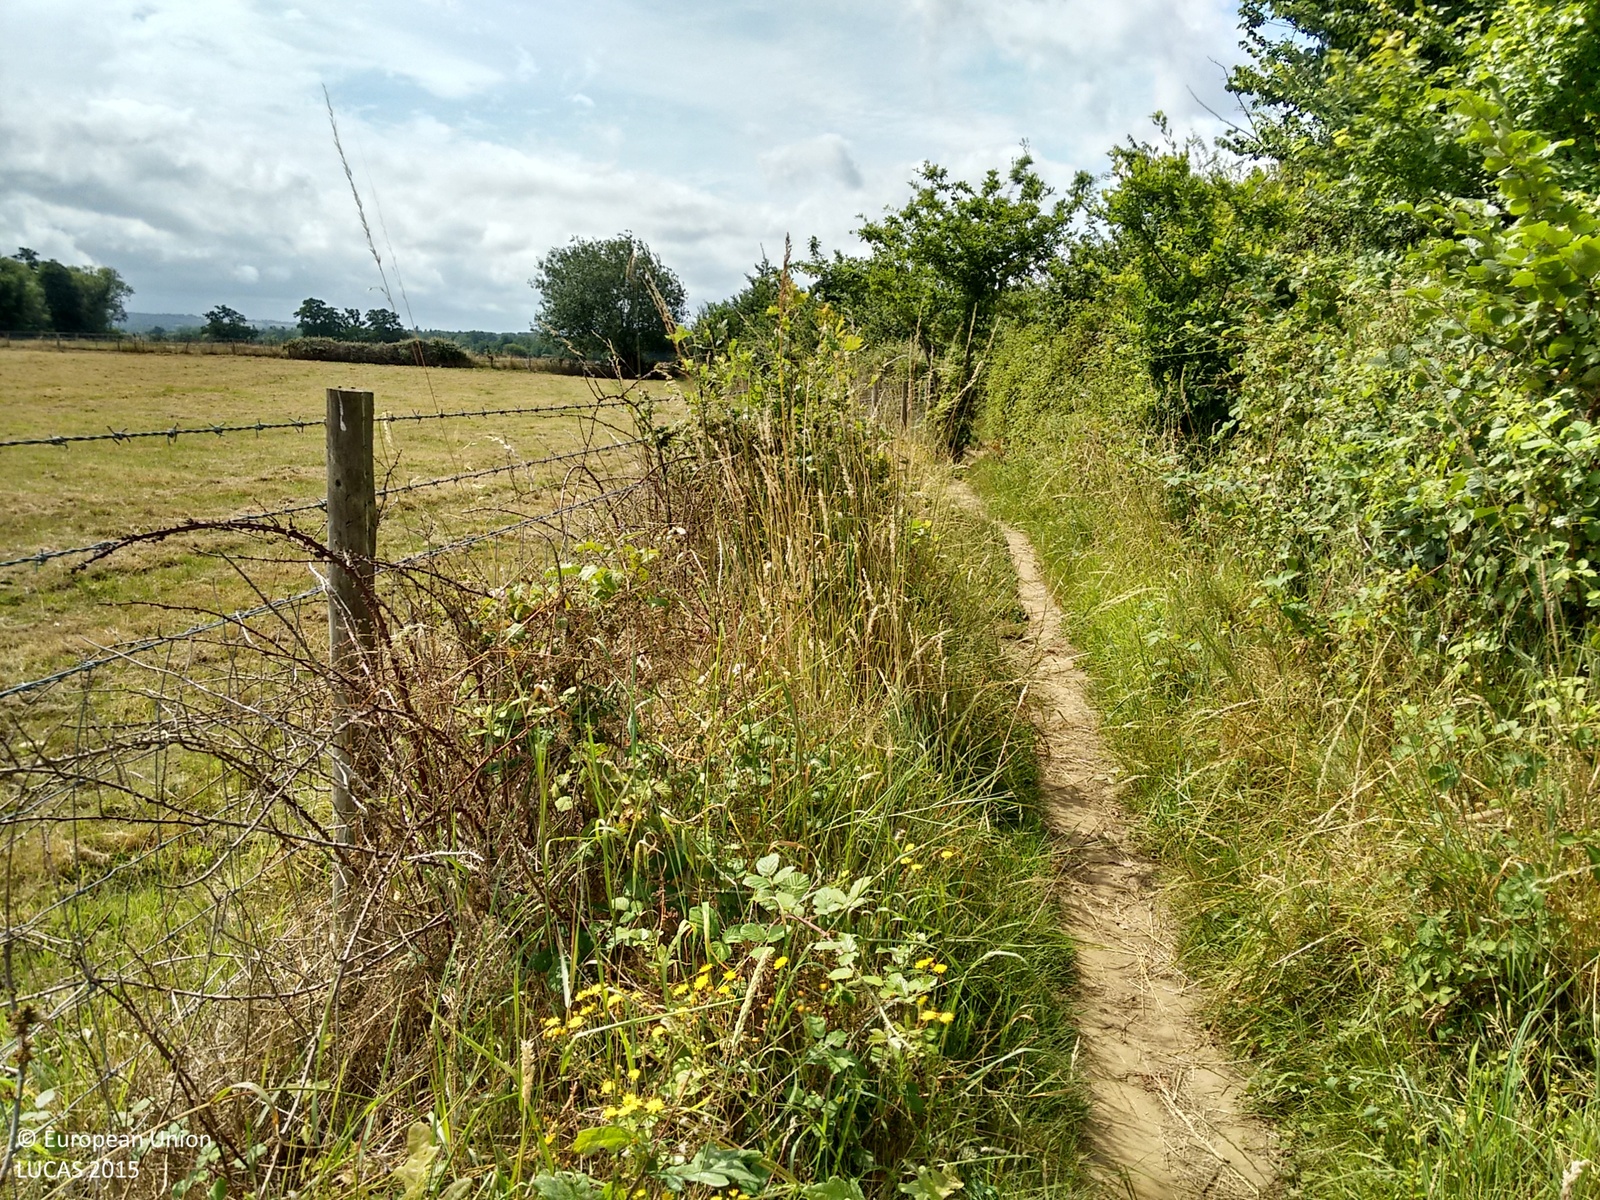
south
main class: Grassland
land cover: Grassland without tree/shrub cover
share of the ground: > 75 %
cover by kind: herbaceous plants 100 %
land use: Agriculture (excluding fallow land and kitchen gardens)
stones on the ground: < 10 %
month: July
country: GB
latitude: 51.2894
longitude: -0.5497
